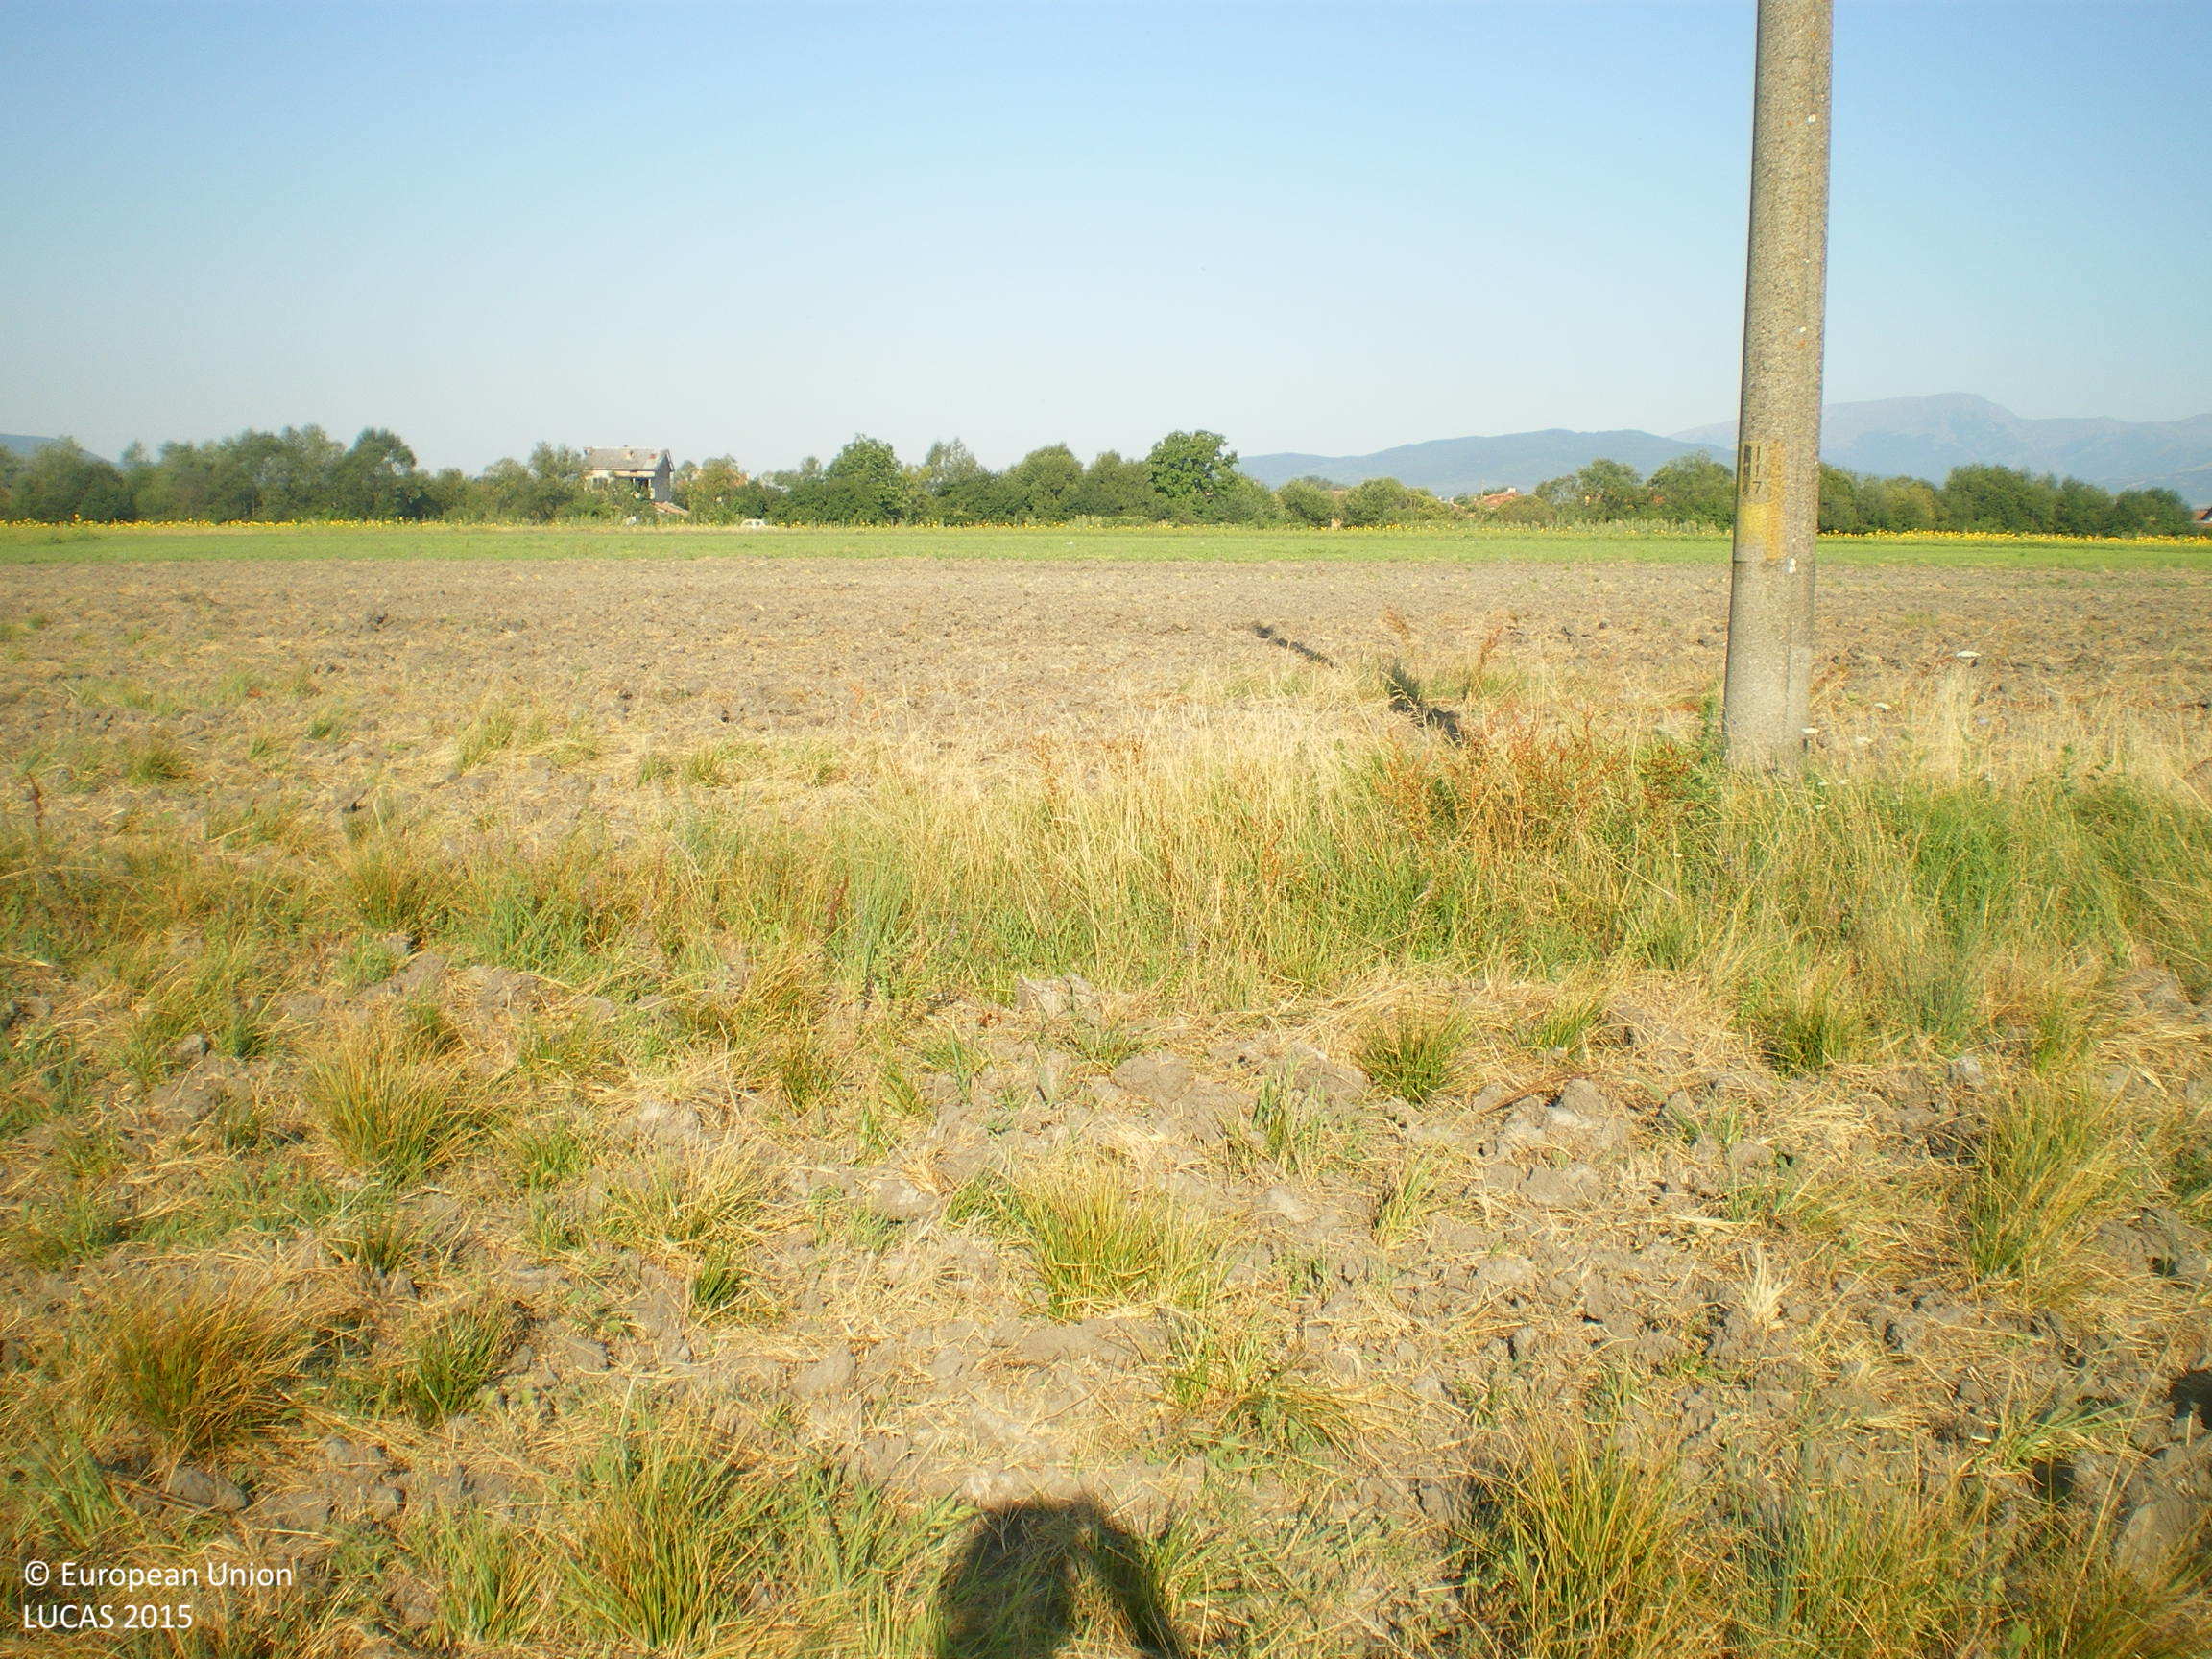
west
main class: Grassland
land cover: Spontaneously vegetated surfaces
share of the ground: 50 - 75 %
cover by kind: herbaceous plants 50 %, unconsolidated bare surface 50 %
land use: Agriculture (excluding fallow land and kitchen gardens)
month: July
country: BG
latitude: 42.6223
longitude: 25.1712
